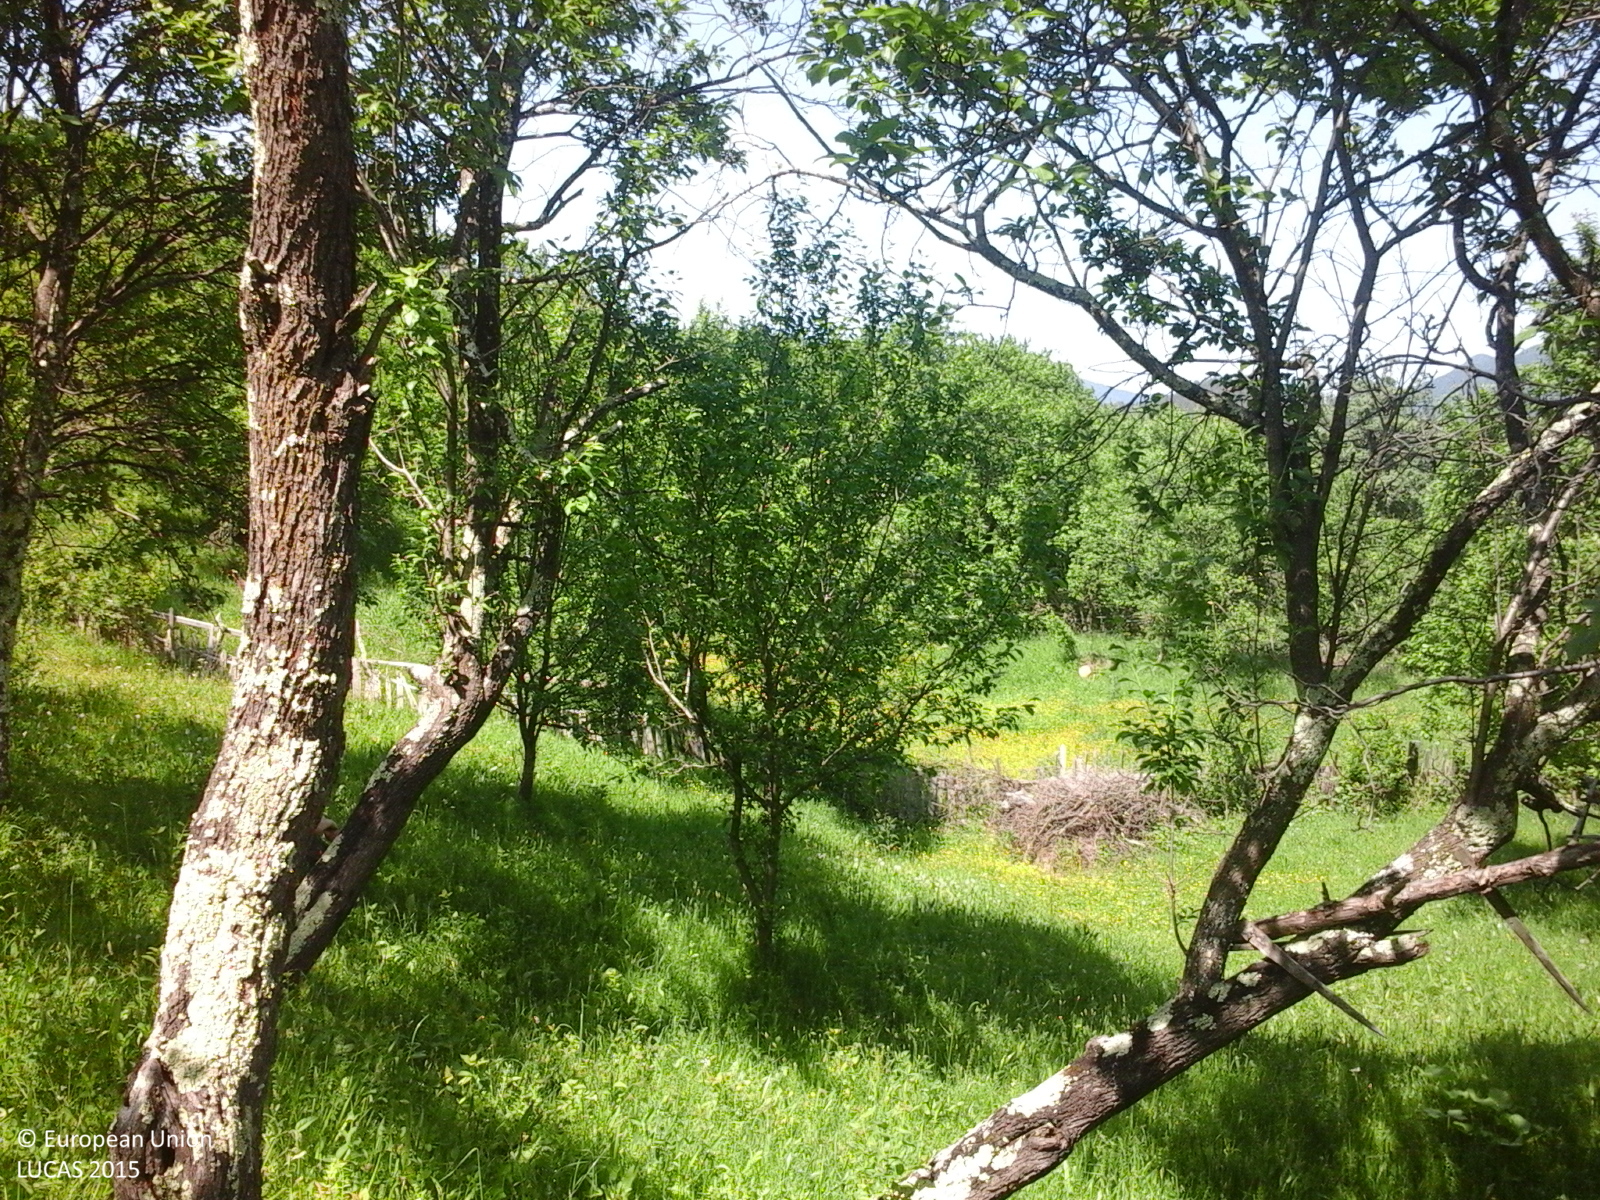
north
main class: Cropland
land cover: Other fruit trees and berries
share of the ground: 50 - 75 %
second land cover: Grassland without tree/shrub cover
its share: > 75 %
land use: Agriculture (excluding fallow land and kitchen gardens)
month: May
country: RO
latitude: 45.4772
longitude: 26.4077
